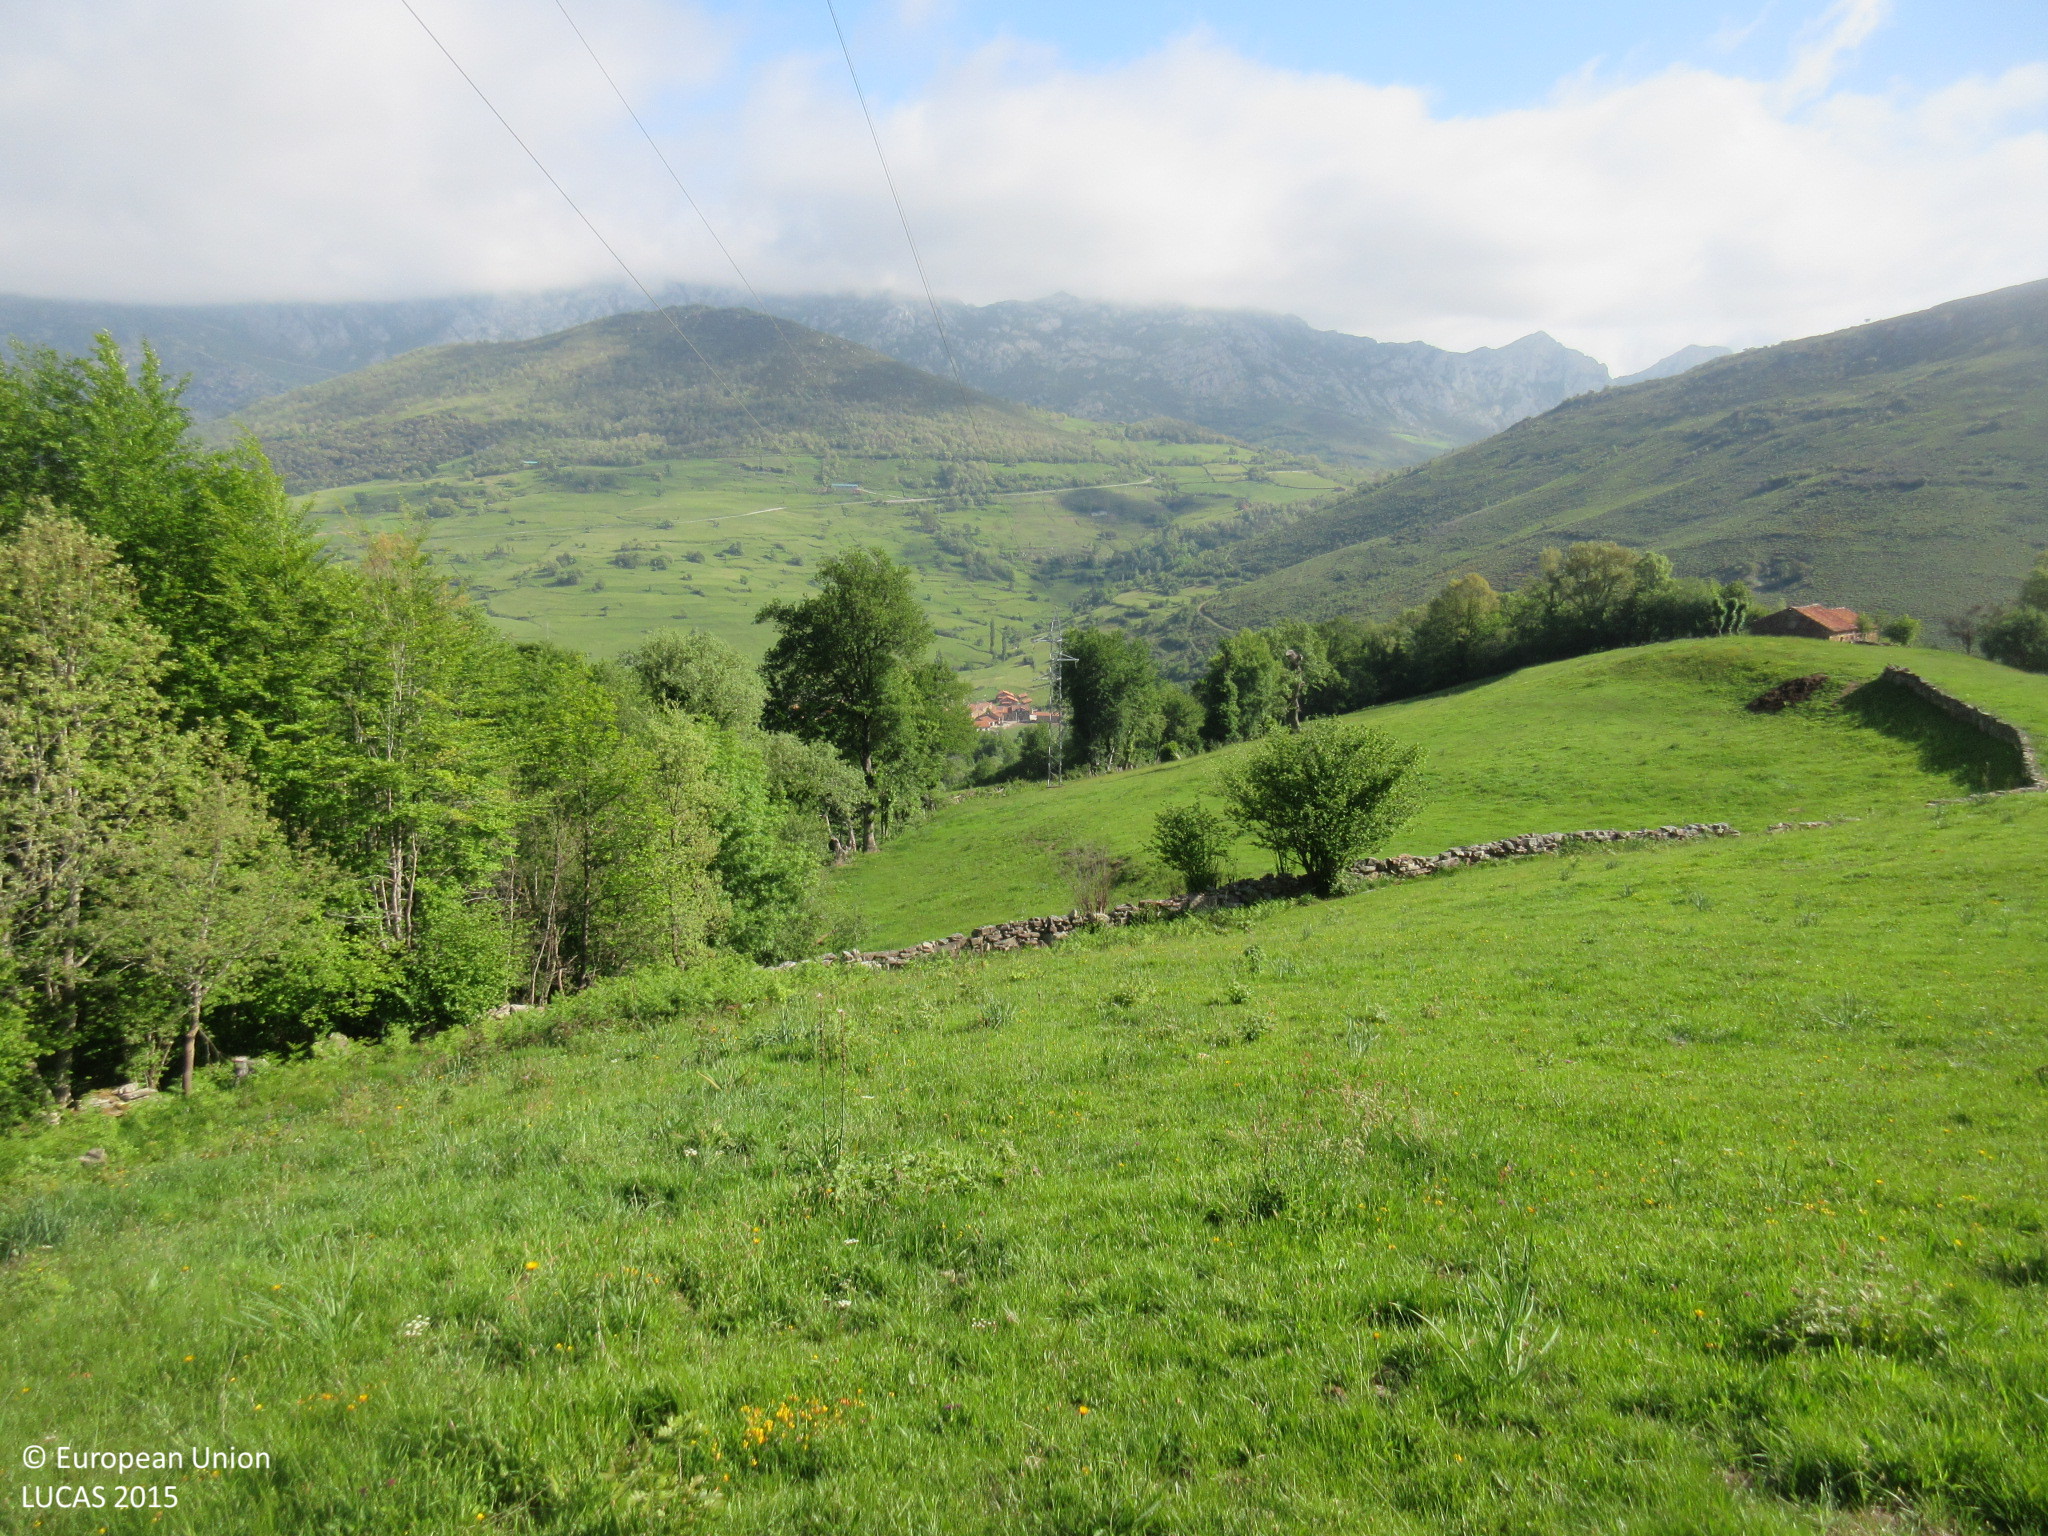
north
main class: Grassland
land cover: Grassland without tree/shrub cover
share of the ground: > 75 %
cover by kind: herbaceous plants 100 %
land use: Agriculture (excluding fallow land and kitchen gardens)
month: May
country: ES
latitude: 43.2269
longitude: -4.5512
